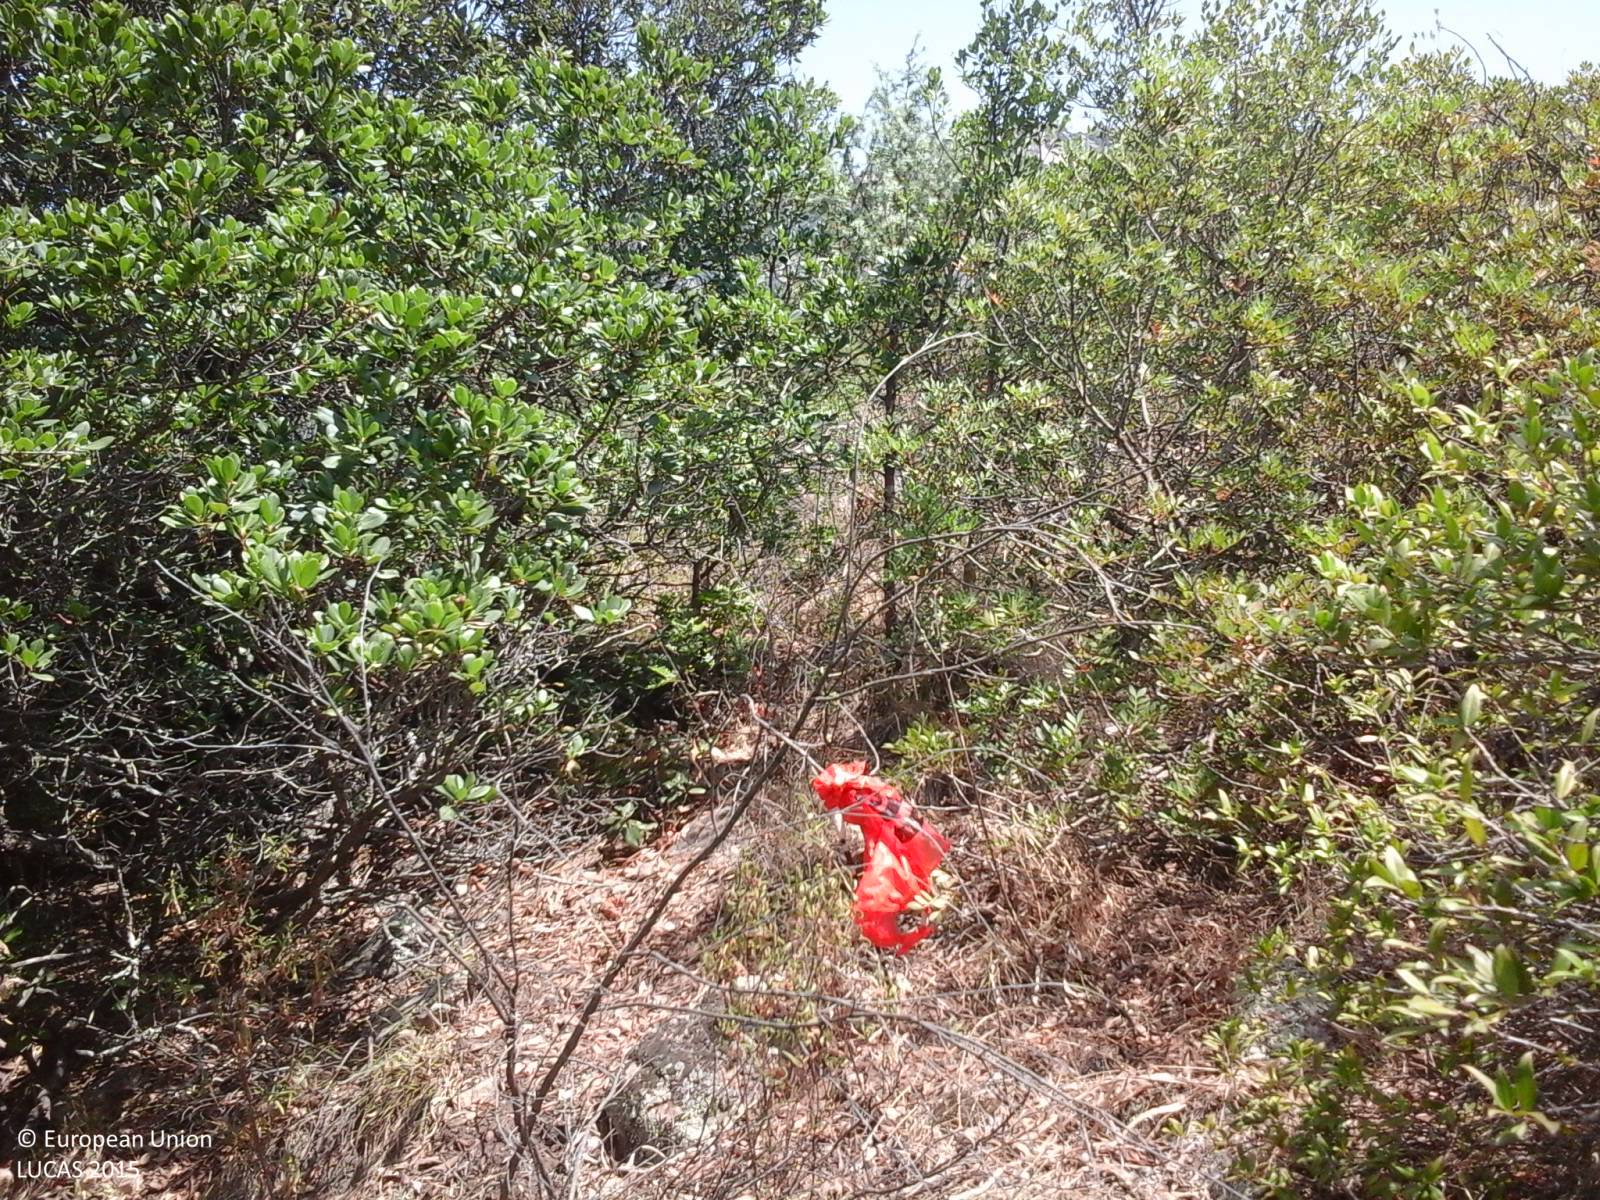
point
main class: Shrubland
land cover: Shrubland with sparse tree cover
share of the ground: > 75 %
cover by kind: shrubs 95 %, broadleaved forest trees 5 %
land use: Semi-natural and natural areas not in use
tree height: > 5 m
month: July
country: IT
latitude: 40.6462
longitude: 9.5175
